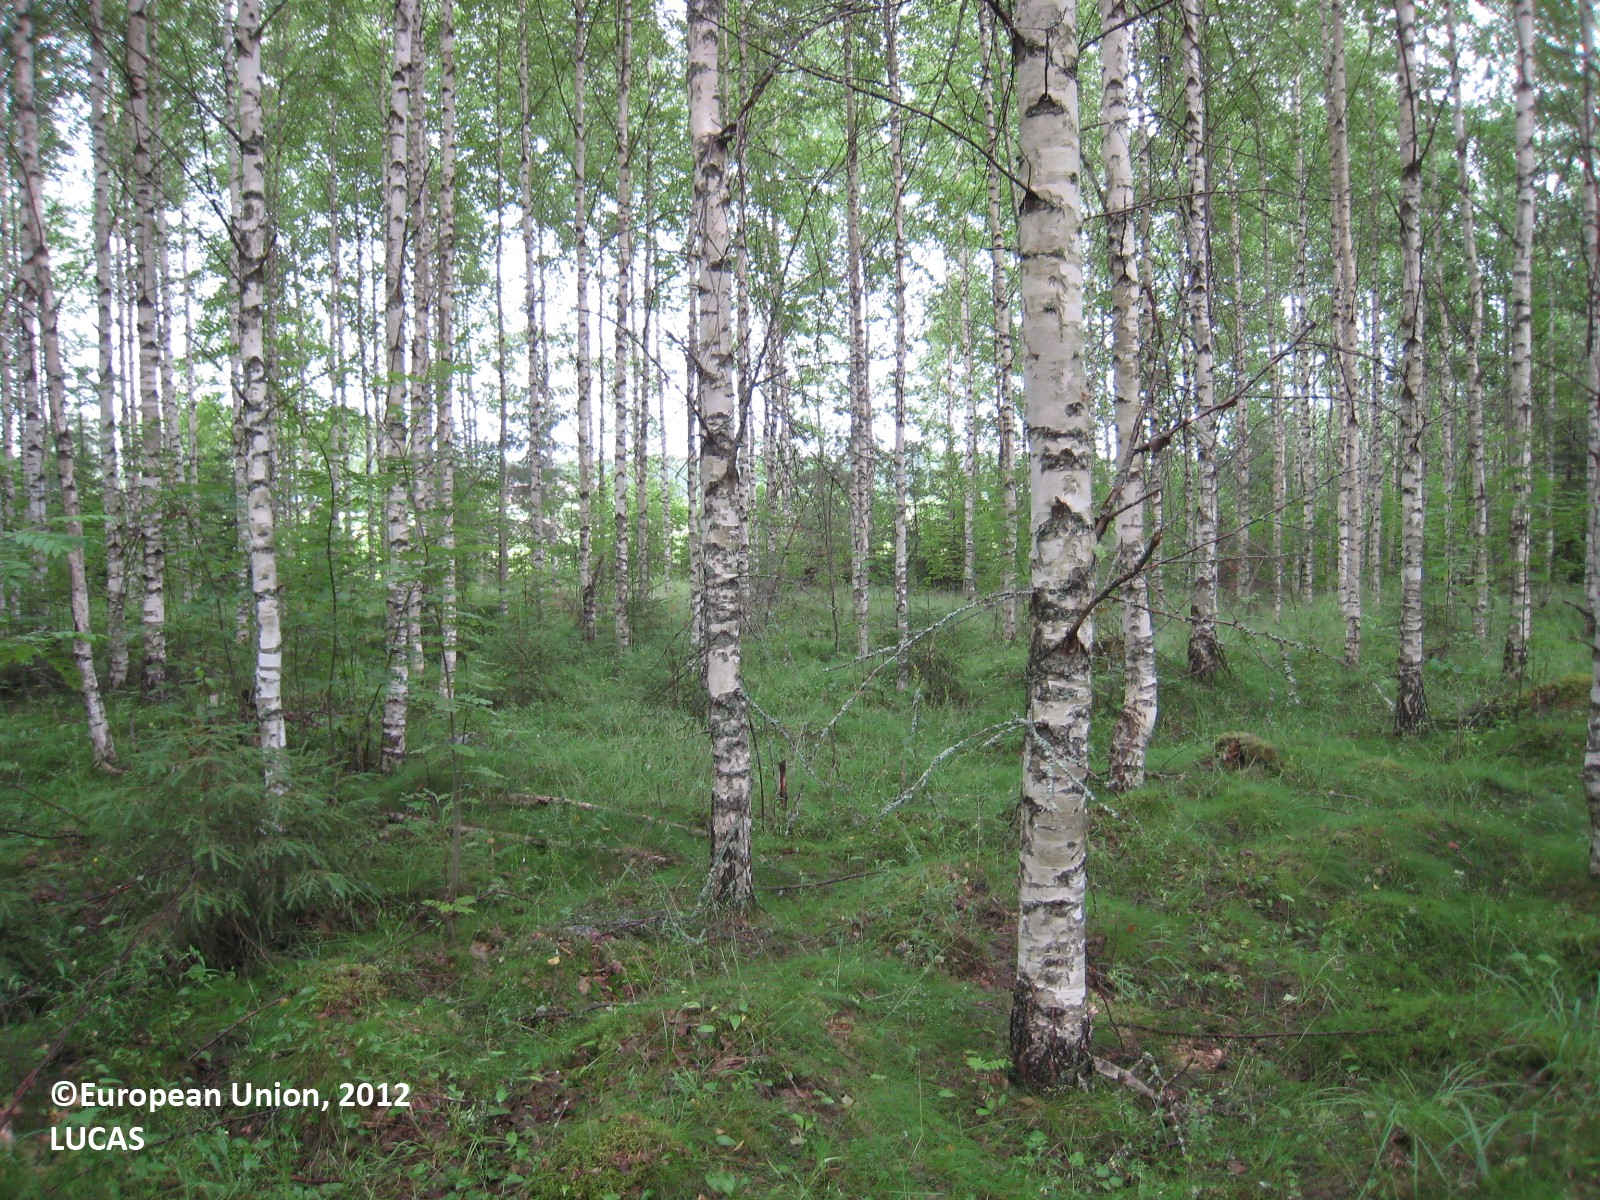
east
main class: Woodland
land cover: Broadleaved woodland
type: non-riverine alder, birch or aspen forest
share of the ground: > 75 %
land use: Forestry
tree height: > 5 m
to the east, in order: Broadleaved woodland; Spruce dominated mixed woodland; Ditches and canals; Shruby margins; Barley; Spontaneously vegetated surfaces; Grassland with sparse tree/shrub cover; Ditches and canals; Grassland with sparse tree/shrub cover; Broadleaved woodland; Temporary grasslands
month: July
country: FI
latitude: 61.7415
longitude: 27.3430
